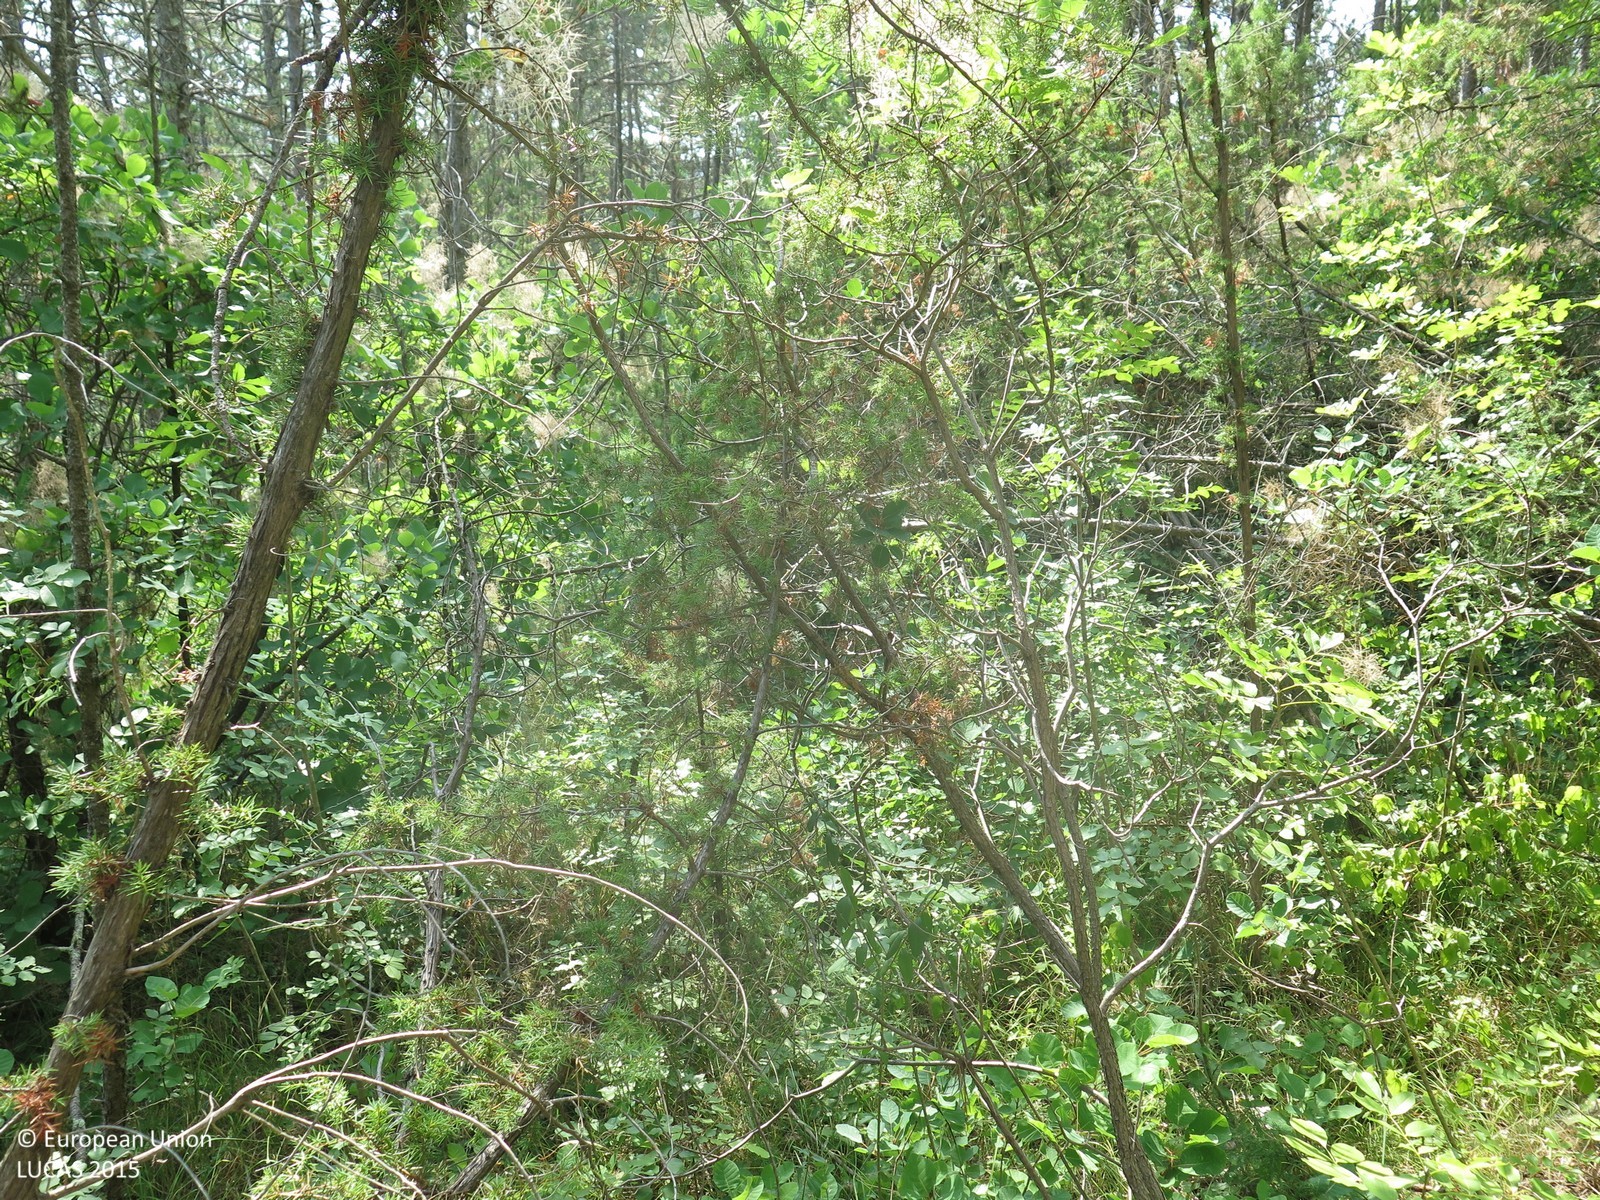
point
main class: Woodland
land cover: Pine dominated mixed woodland
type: coniferous forest of the mediterranean region
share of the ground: > 75 %
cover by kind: coniferous forest trees 75 %, broadleaved forest trees 25 %
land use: Semi-natural and natural areas not in use
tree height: > 5 m
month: July
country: HR
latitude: 45.2260
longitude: 14.1085
